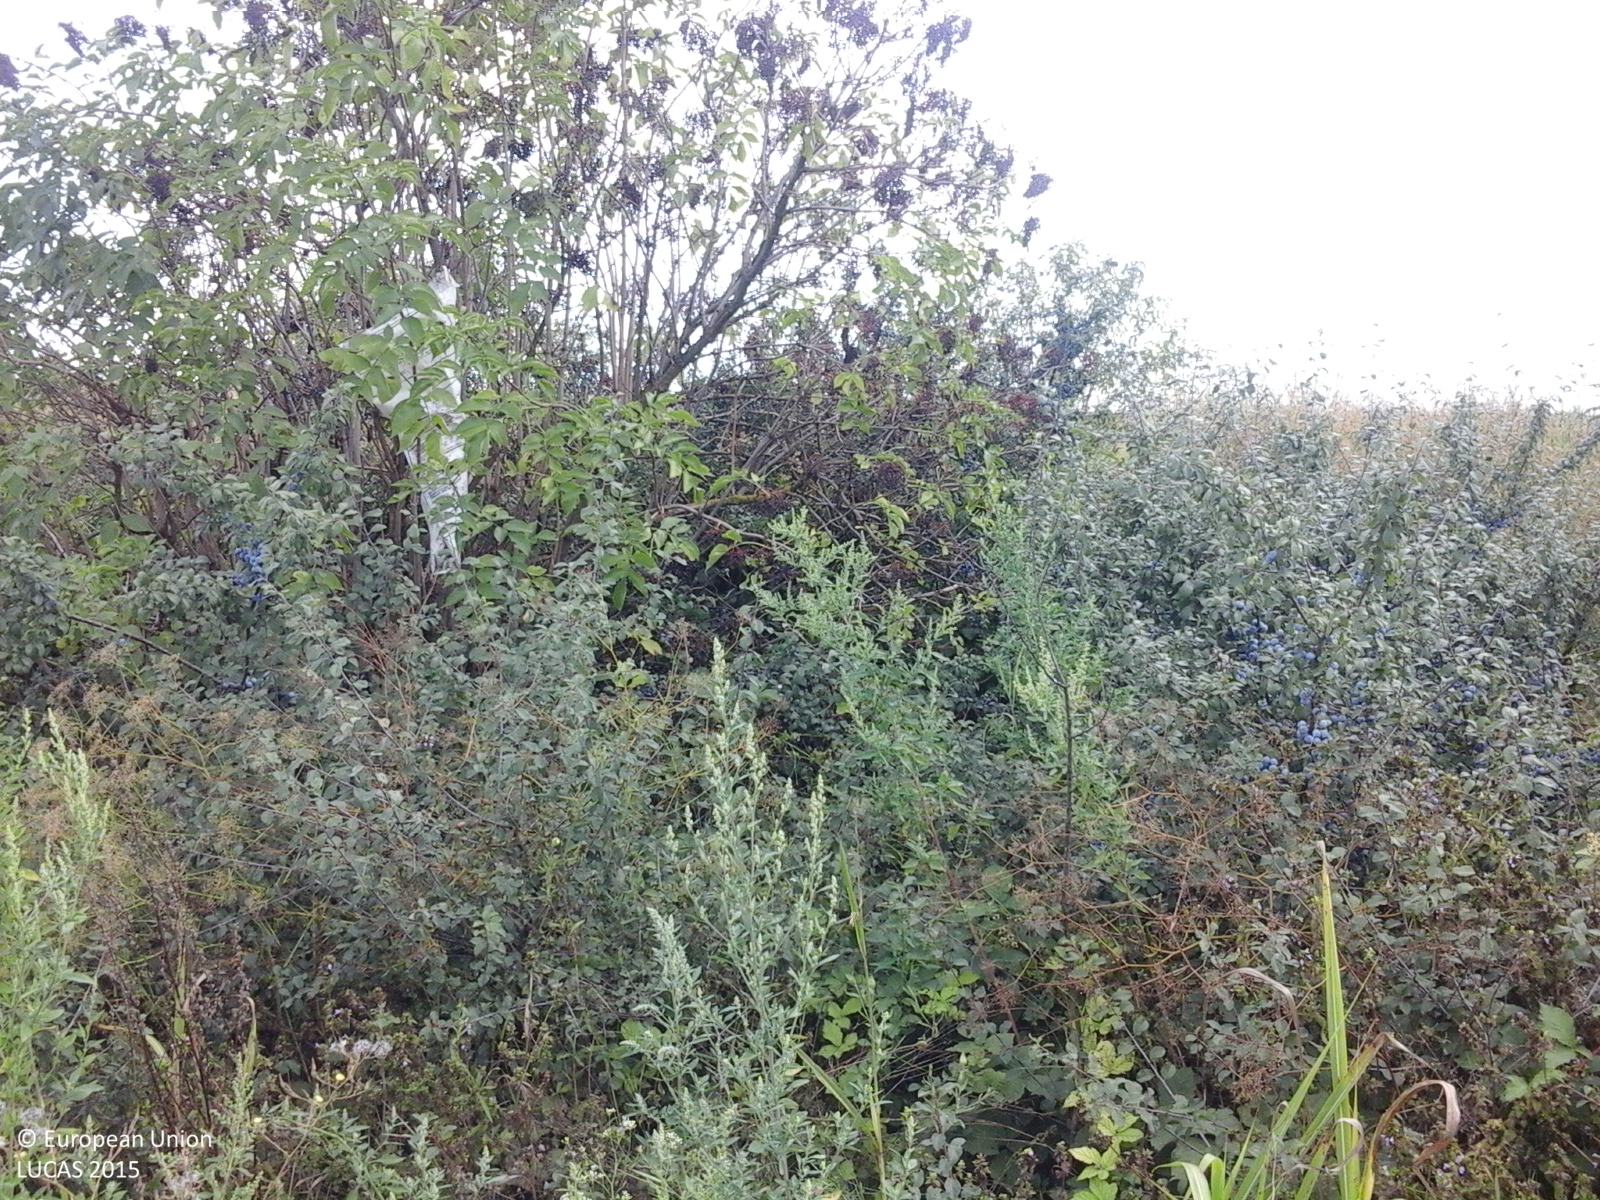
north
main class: Cropland
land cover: Maize
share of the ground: > 75 %
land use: Agriculture (excluding fallow land and kitchen gardens)
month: August
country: RO
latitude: 46.2322
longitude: 21.0398
